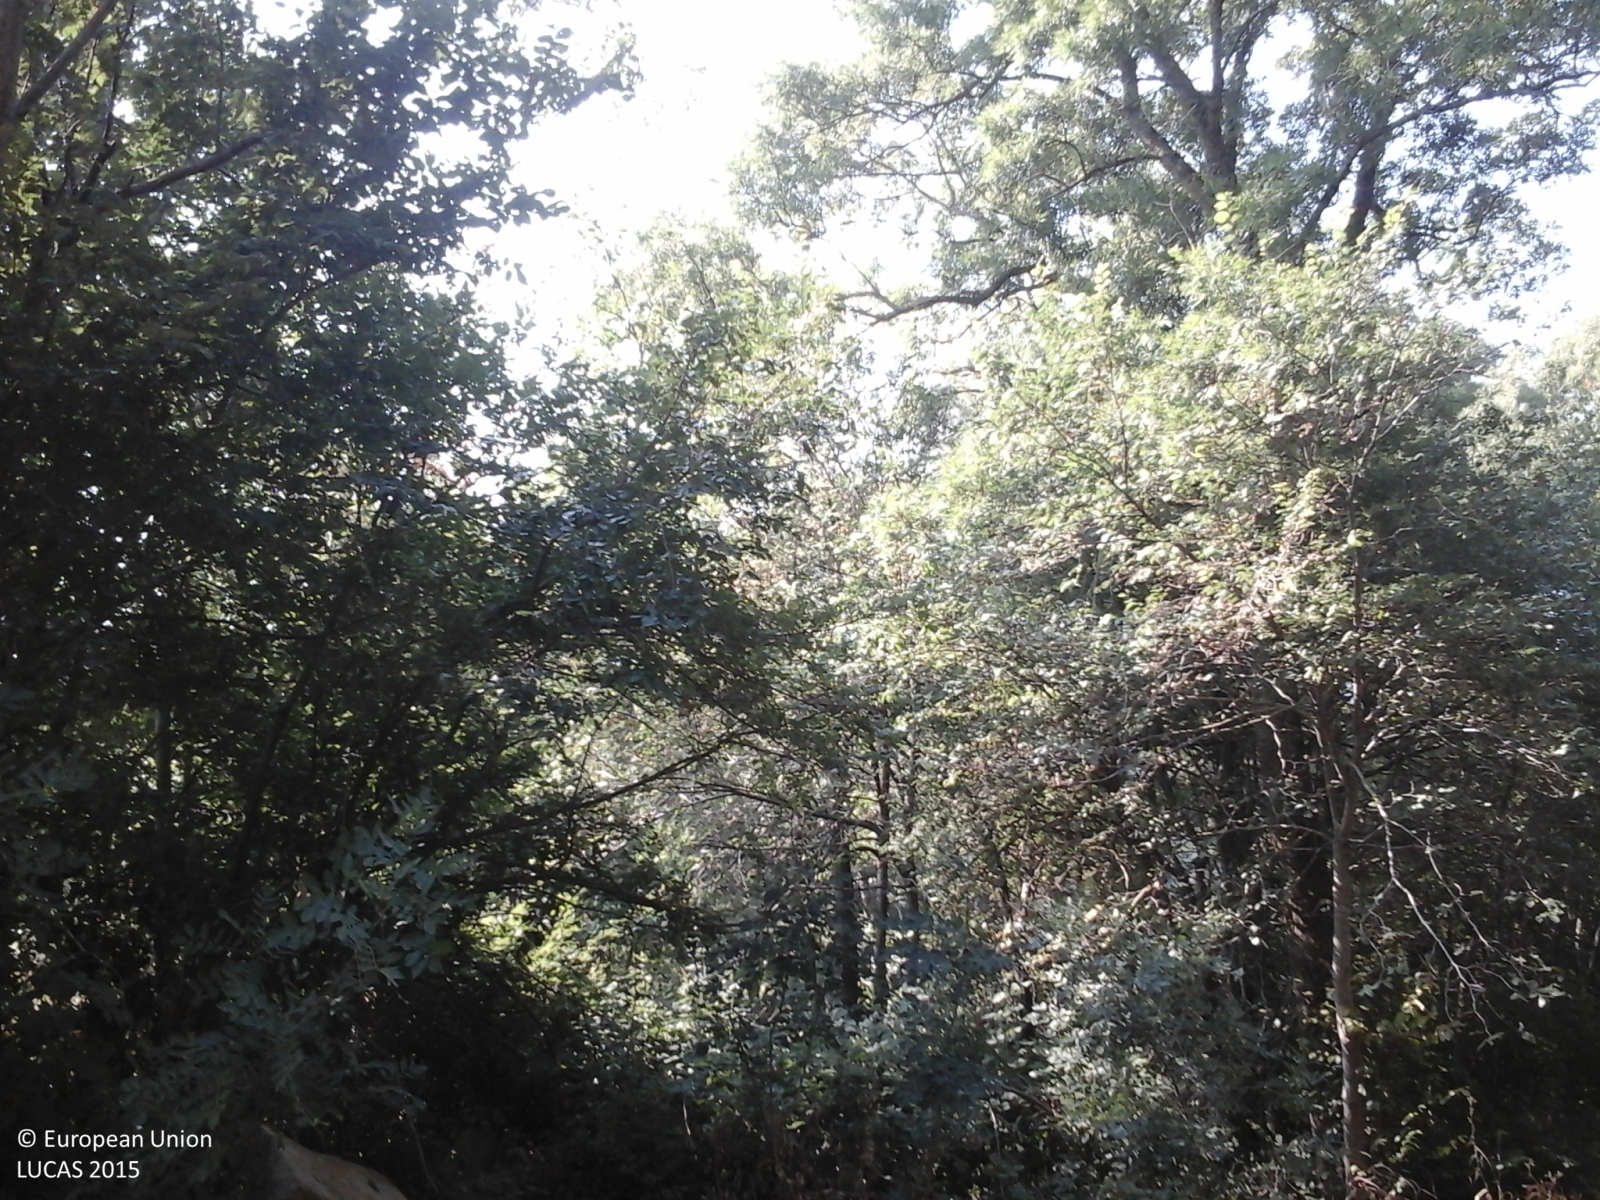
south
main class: Woodland
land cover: Broadleaved woodland
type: thermophilous deciduous forest
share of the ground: > 75 %
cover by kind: broadleaved forest trees 90 %, shrubs 5 %, herbaceous plants 5 %
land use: Forestry
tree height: > 5 m
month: August
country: IT
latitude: 41.4386
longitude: 15.1168
